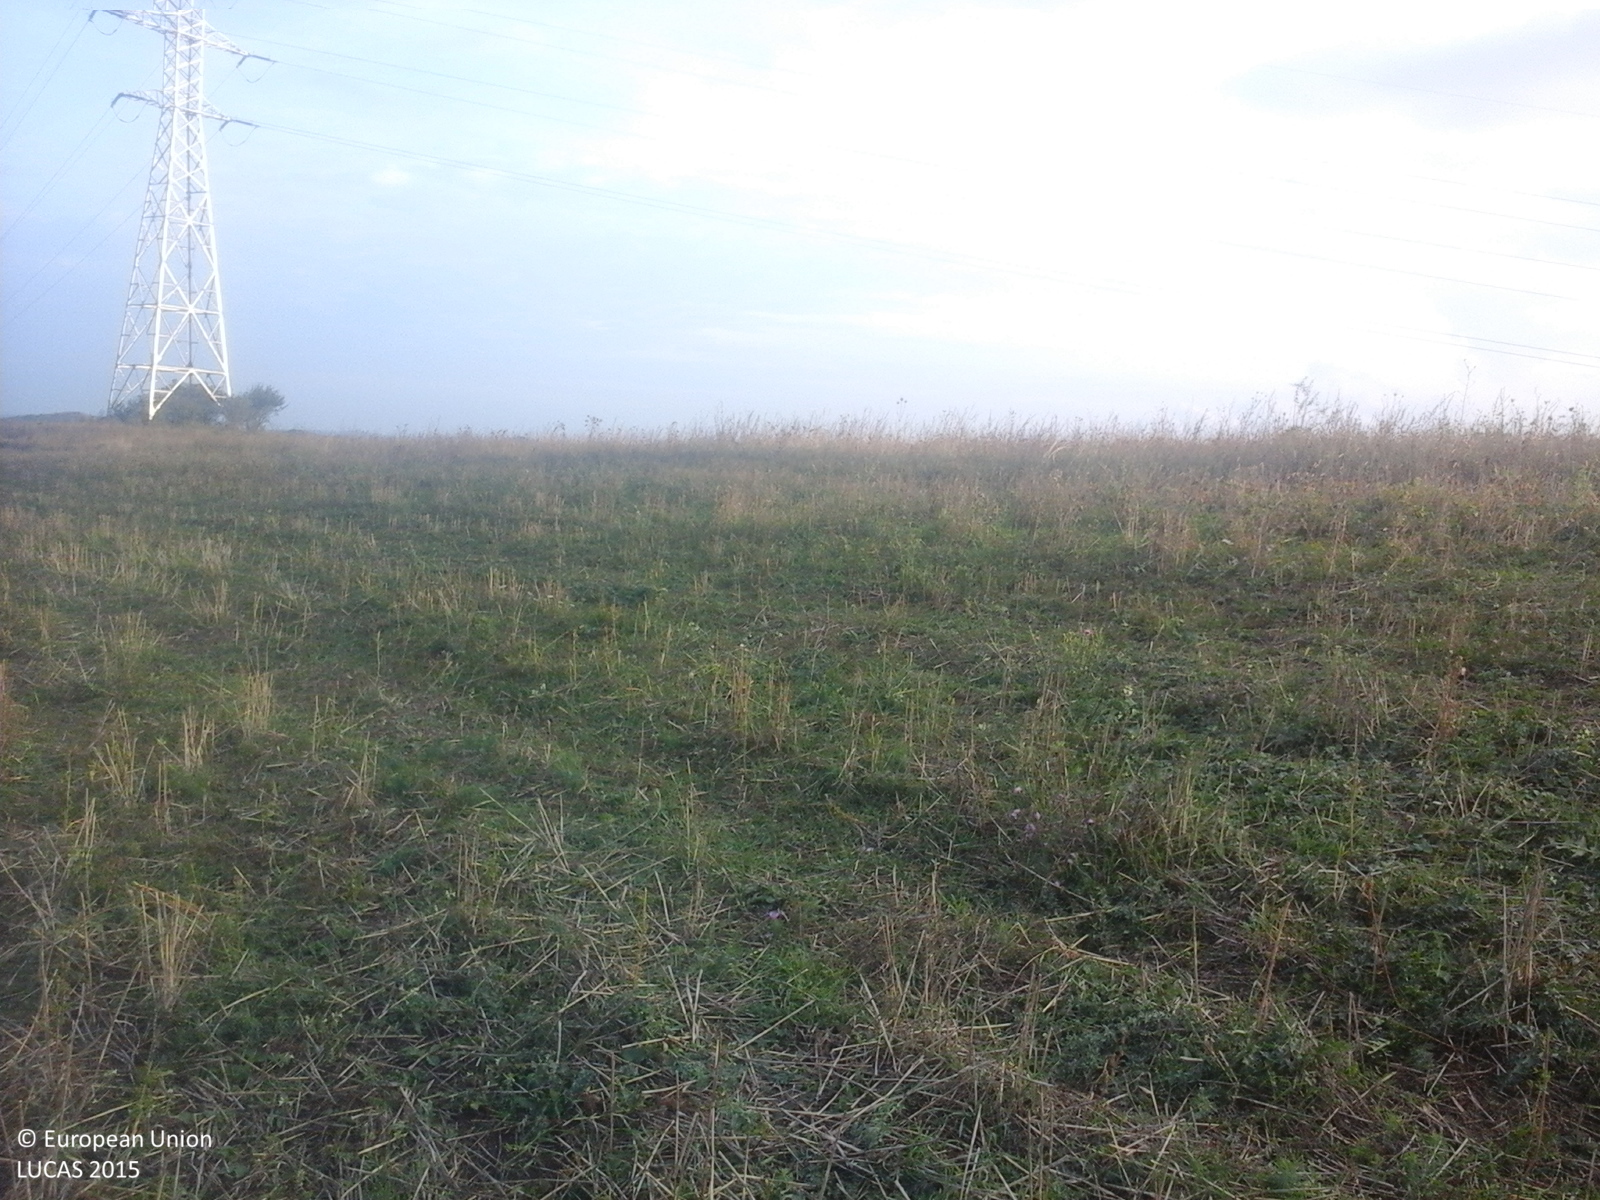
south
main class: Cropland
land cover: Common wheat
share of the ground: 10 - 25 %
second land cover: Spontaneously vegetated surfaces
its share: 25 - 50 %
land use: Agriculture (excluding fallow land and kitchen gardens)
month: October
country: RO
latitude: 46.5161
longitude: 24.0372
